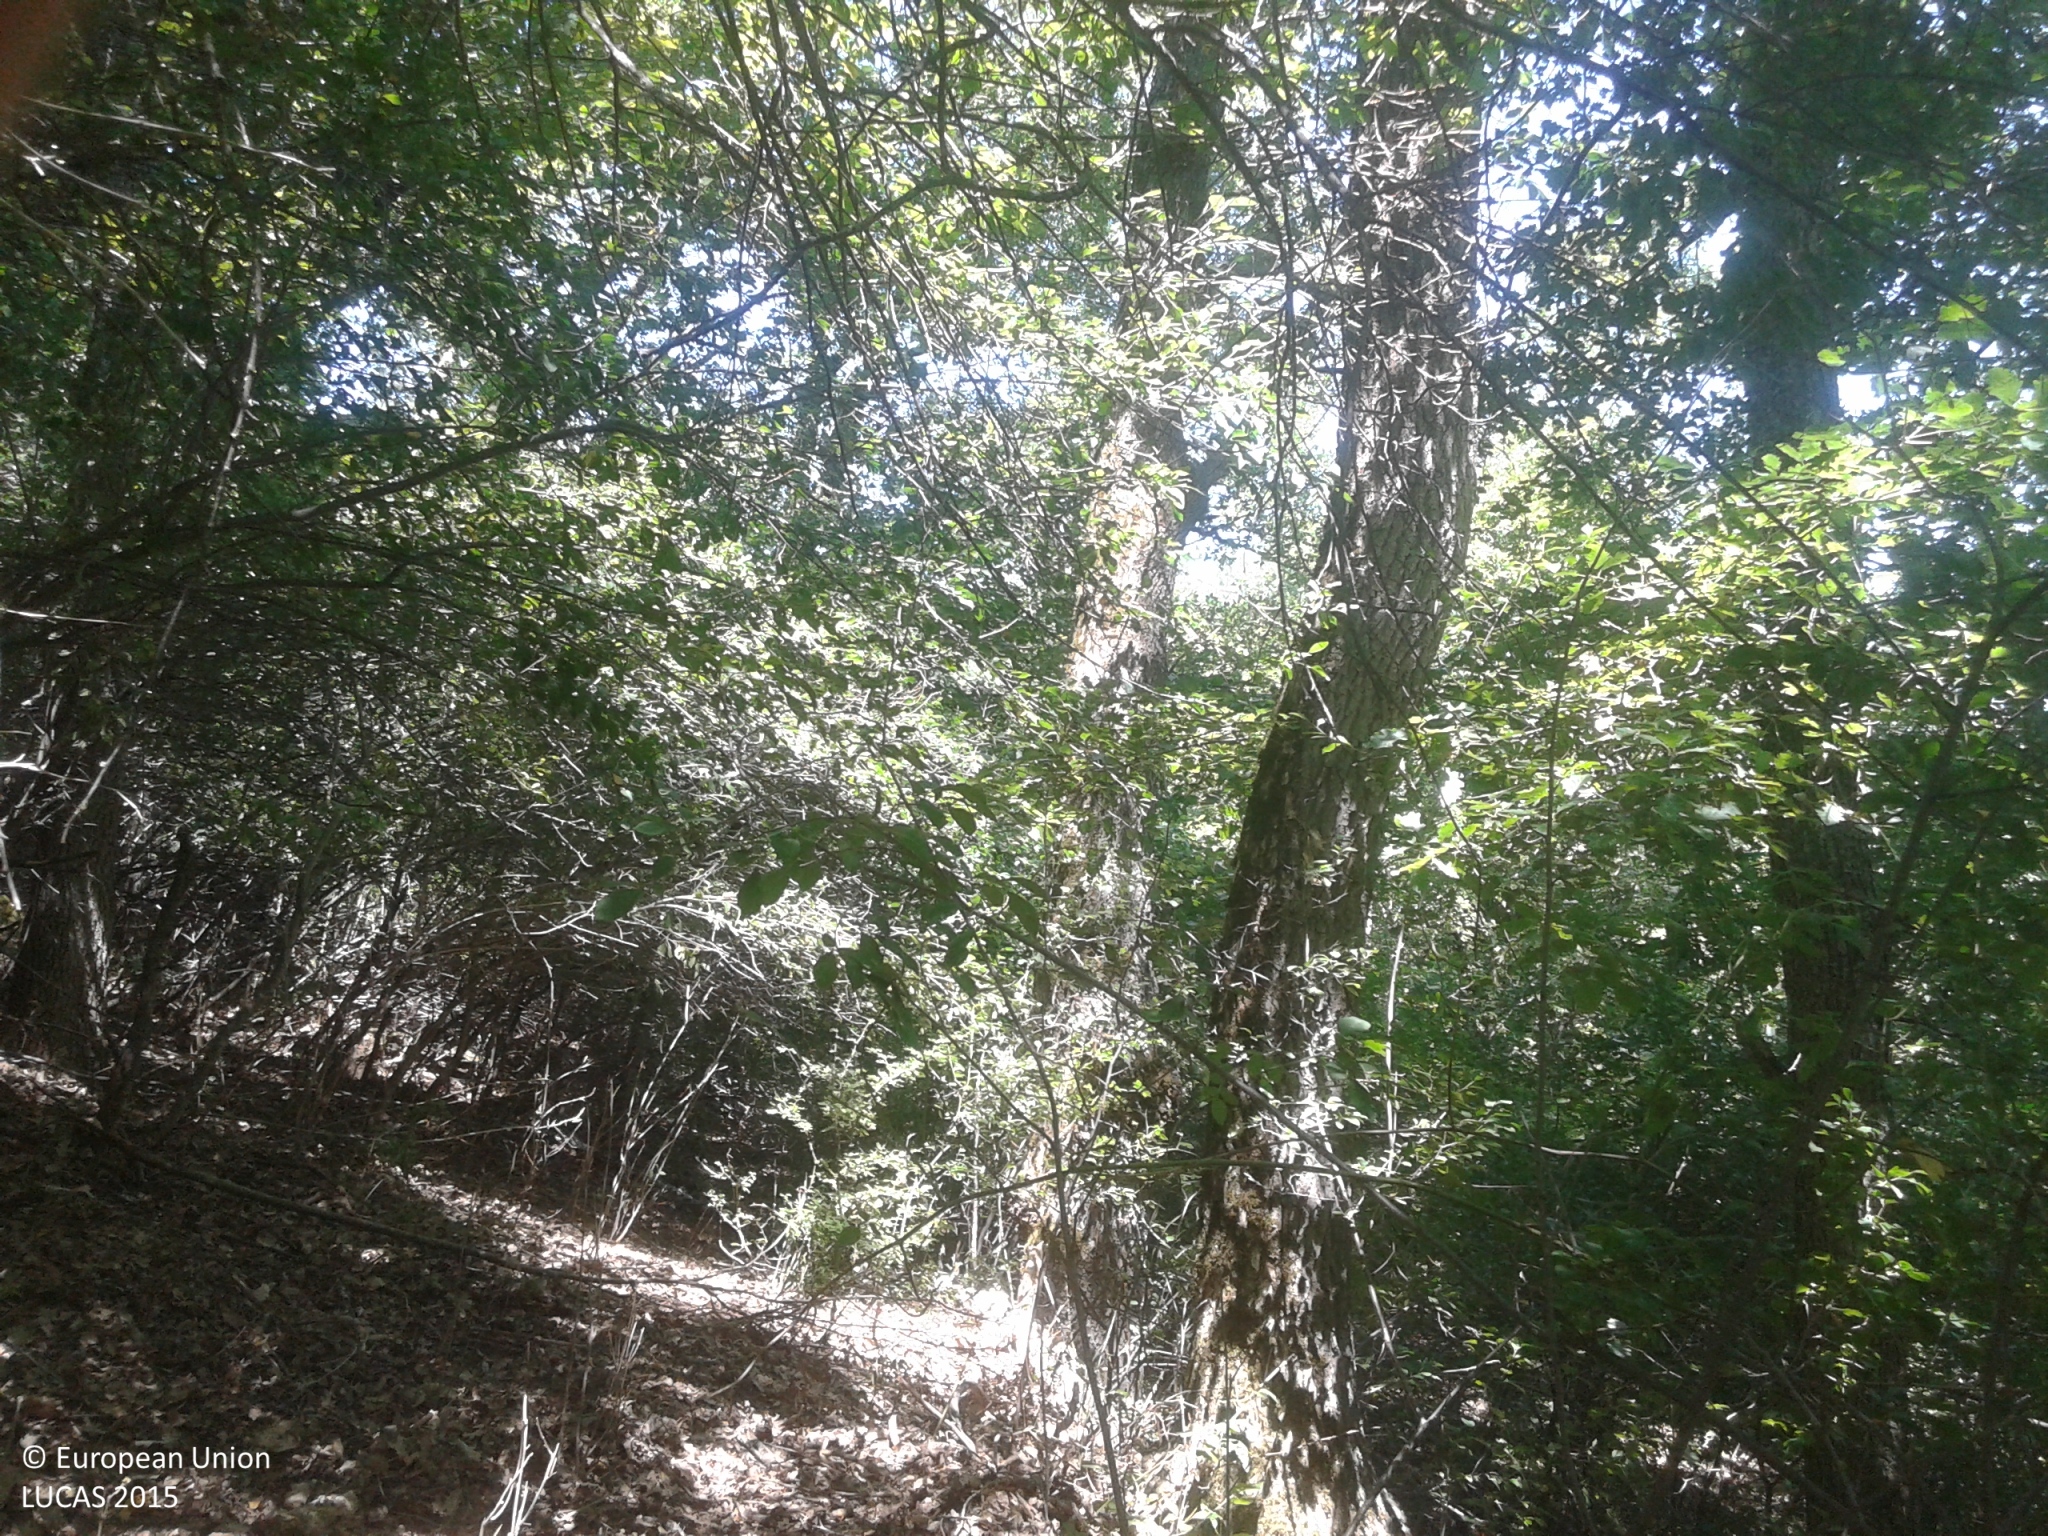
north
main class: Woodland
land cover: Broadleaved woodland
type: thermophilous deciduous forest
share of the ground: > 75 %
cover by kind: broadleaved forest trees 95 %, shrubs 5 %
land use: Semi-natural and natural areas not in use
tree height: > 5 m
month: July
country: ES
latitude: 42.3368
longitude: 1.5510
